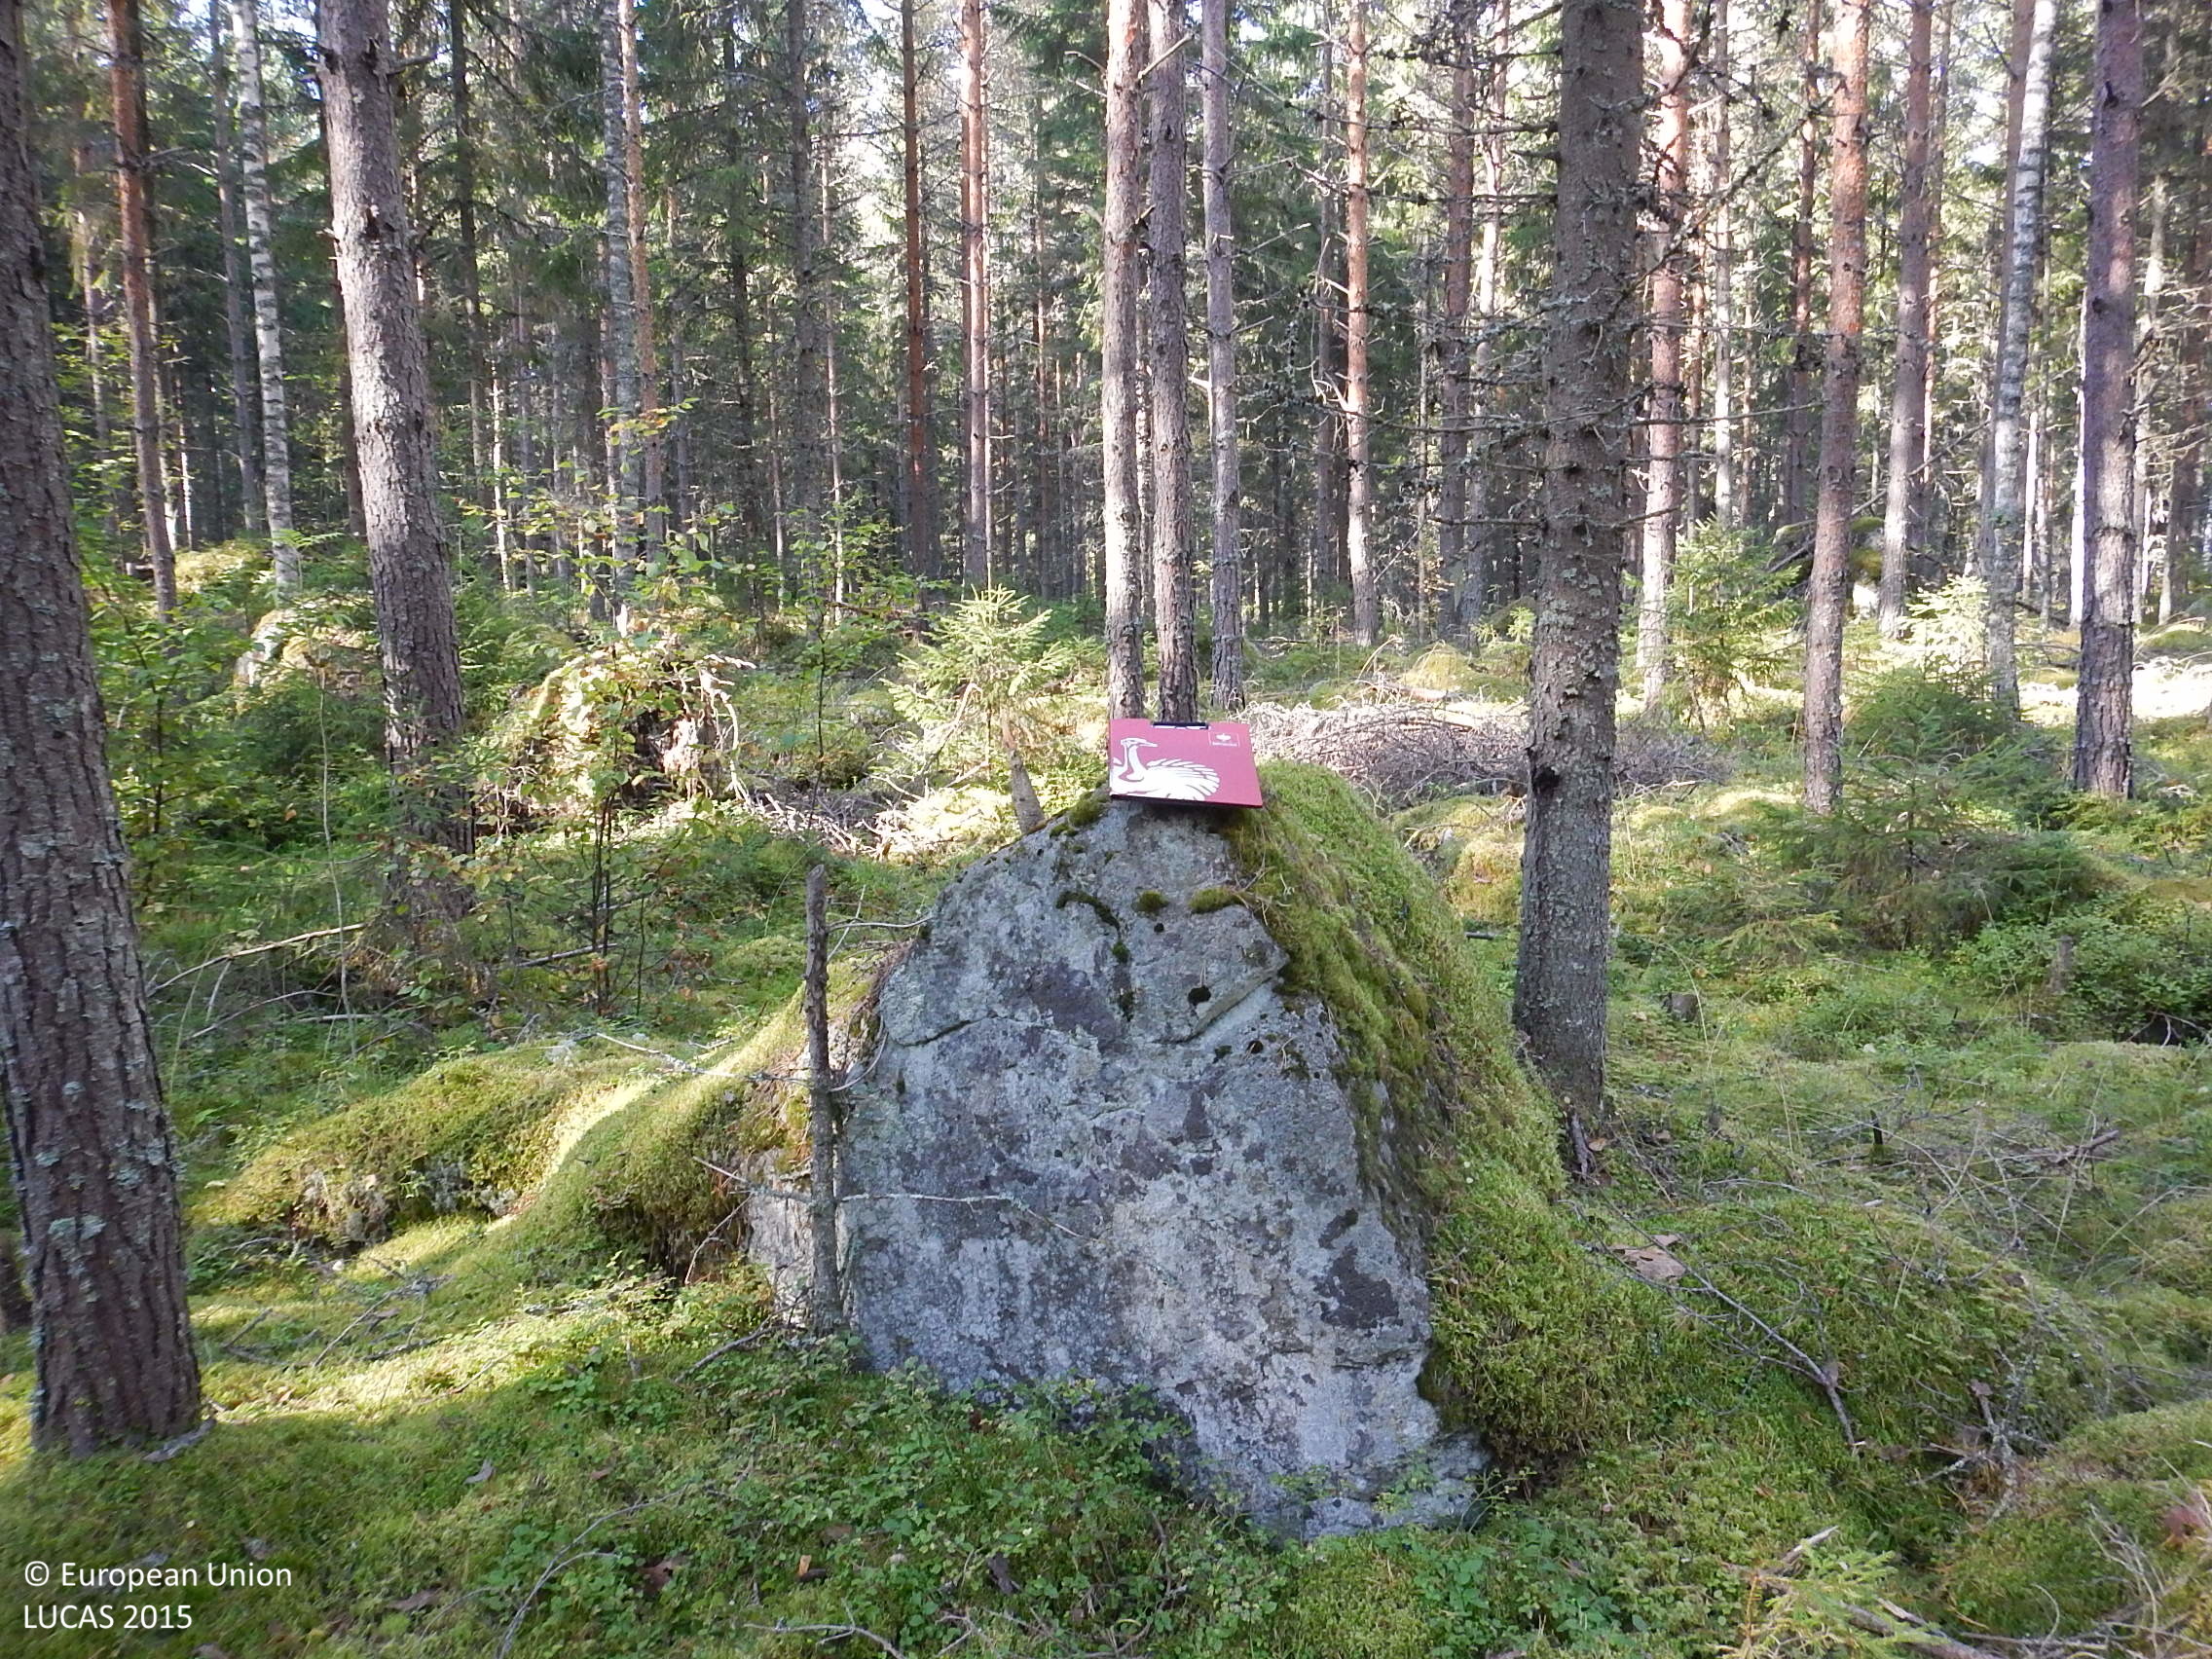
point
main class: Woodland
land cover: Pine dominated coniferous woodland
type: boreal forest
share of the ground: > 75 %
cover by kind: coniferous forest trees 75 %, lichens and mosses 25 %
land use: Forestry
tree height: > 5 m
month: September
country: FI
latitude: 61.6250
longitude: 22.1485
